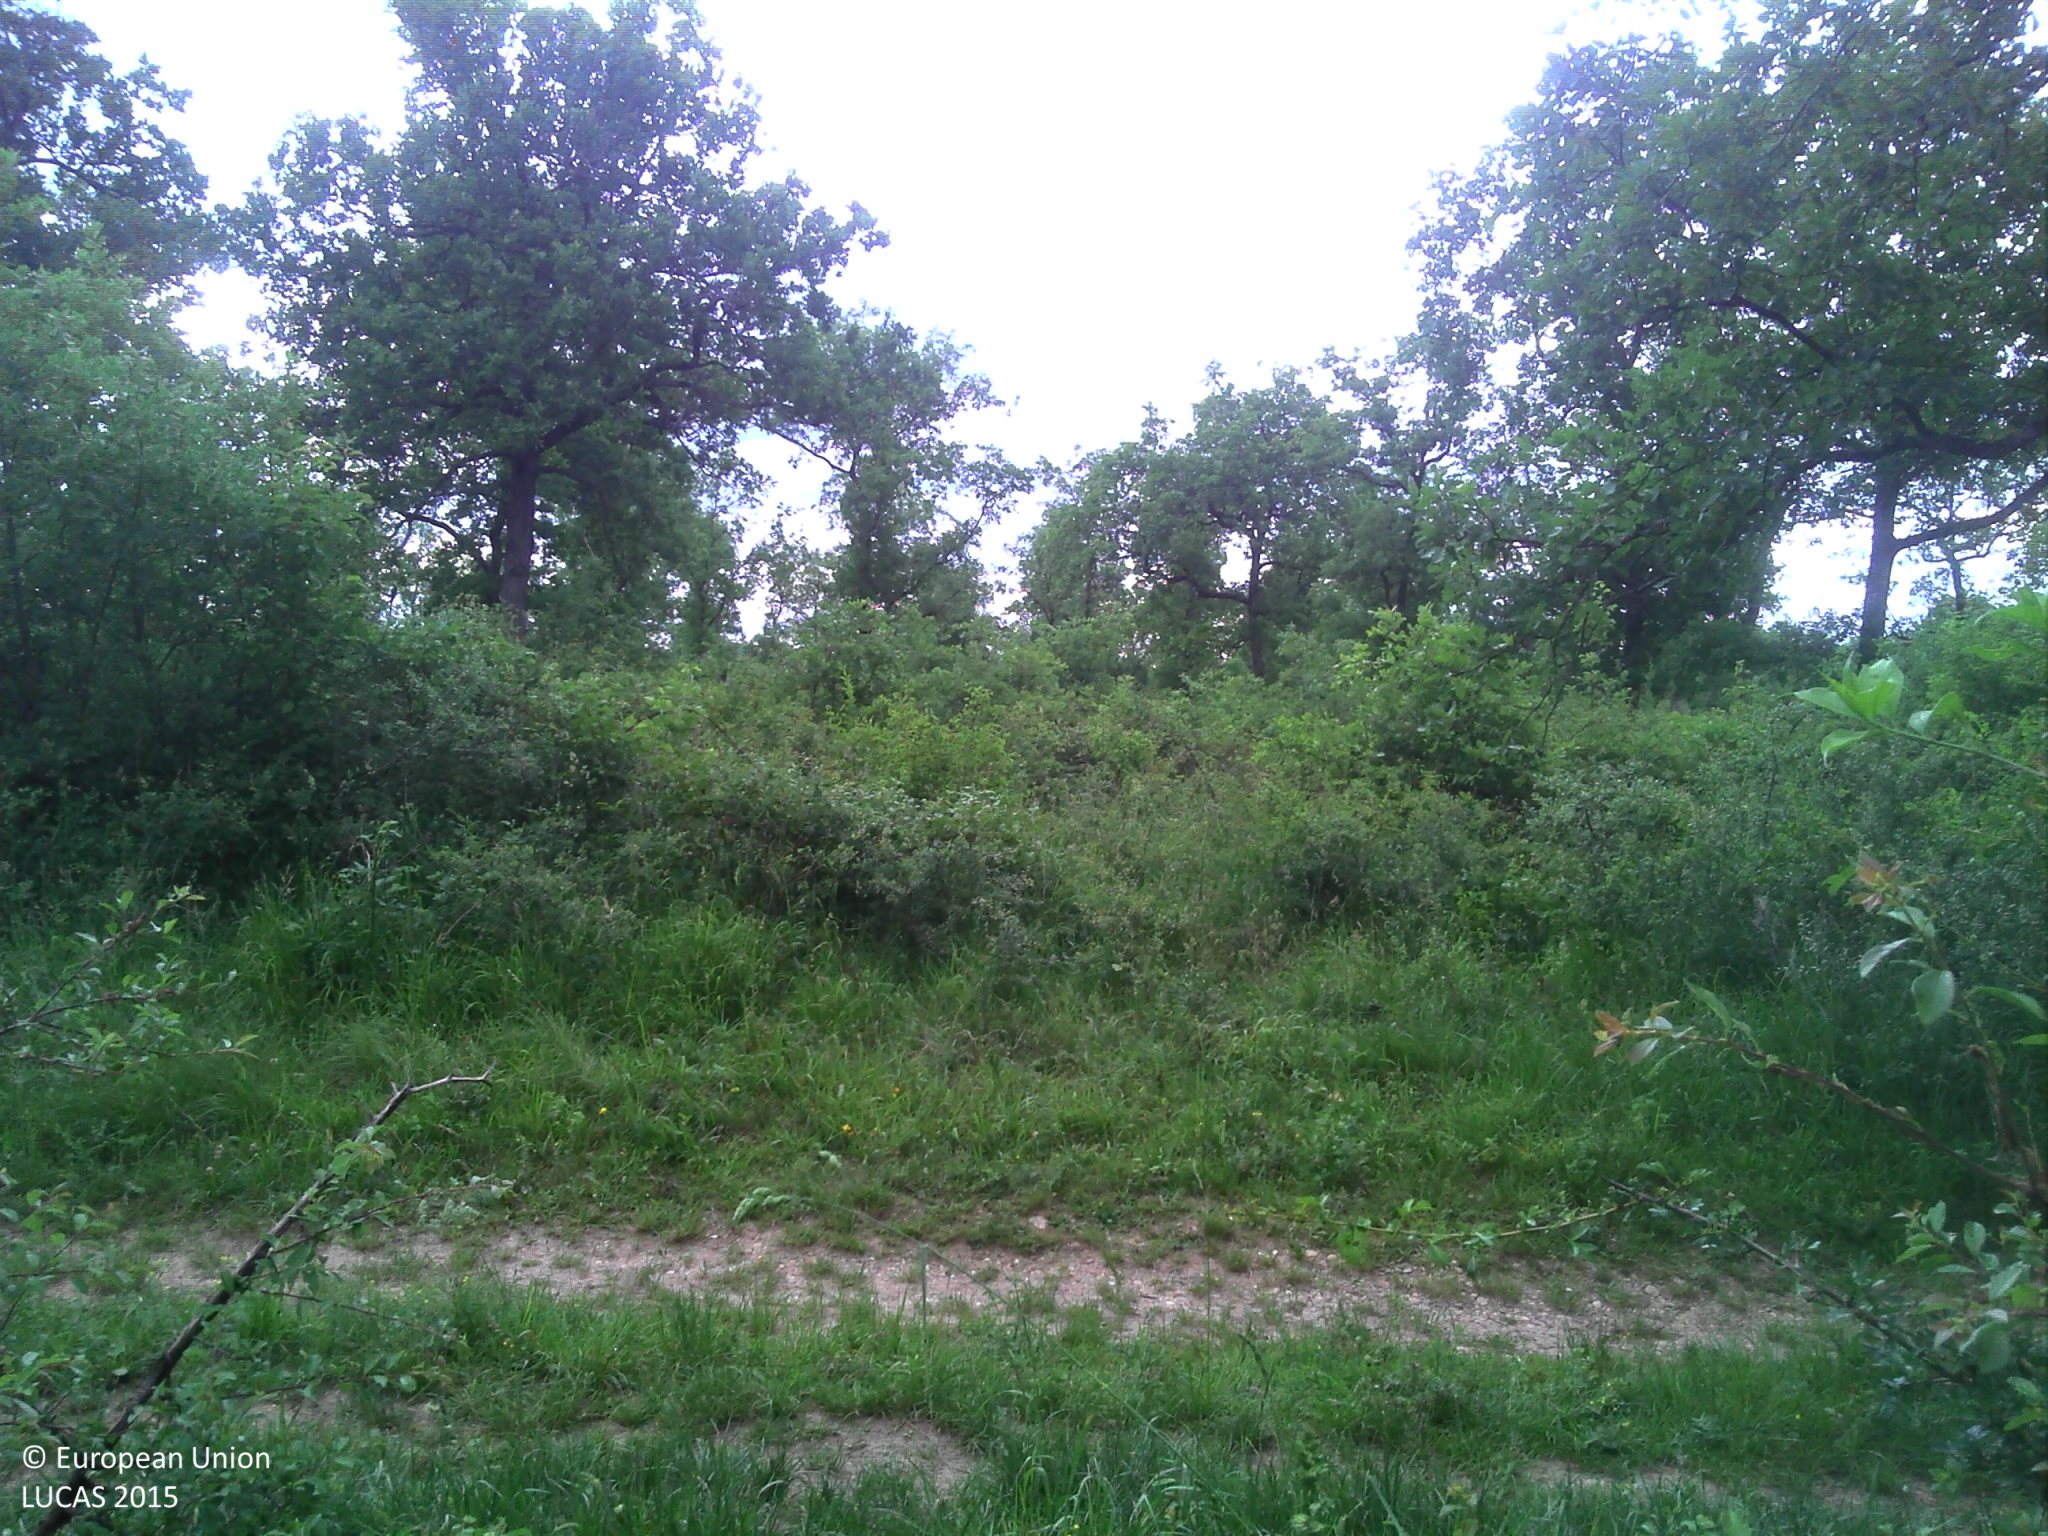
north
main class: Woodland
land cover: Broadleaved woodland
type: mesophytic deciduous forest
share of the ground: > 75 %
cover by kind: broadleaved forest trees 100 %
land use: Forestry
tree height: > 5 m
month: June
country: FR
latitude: 47.9245
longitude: 7.4719
